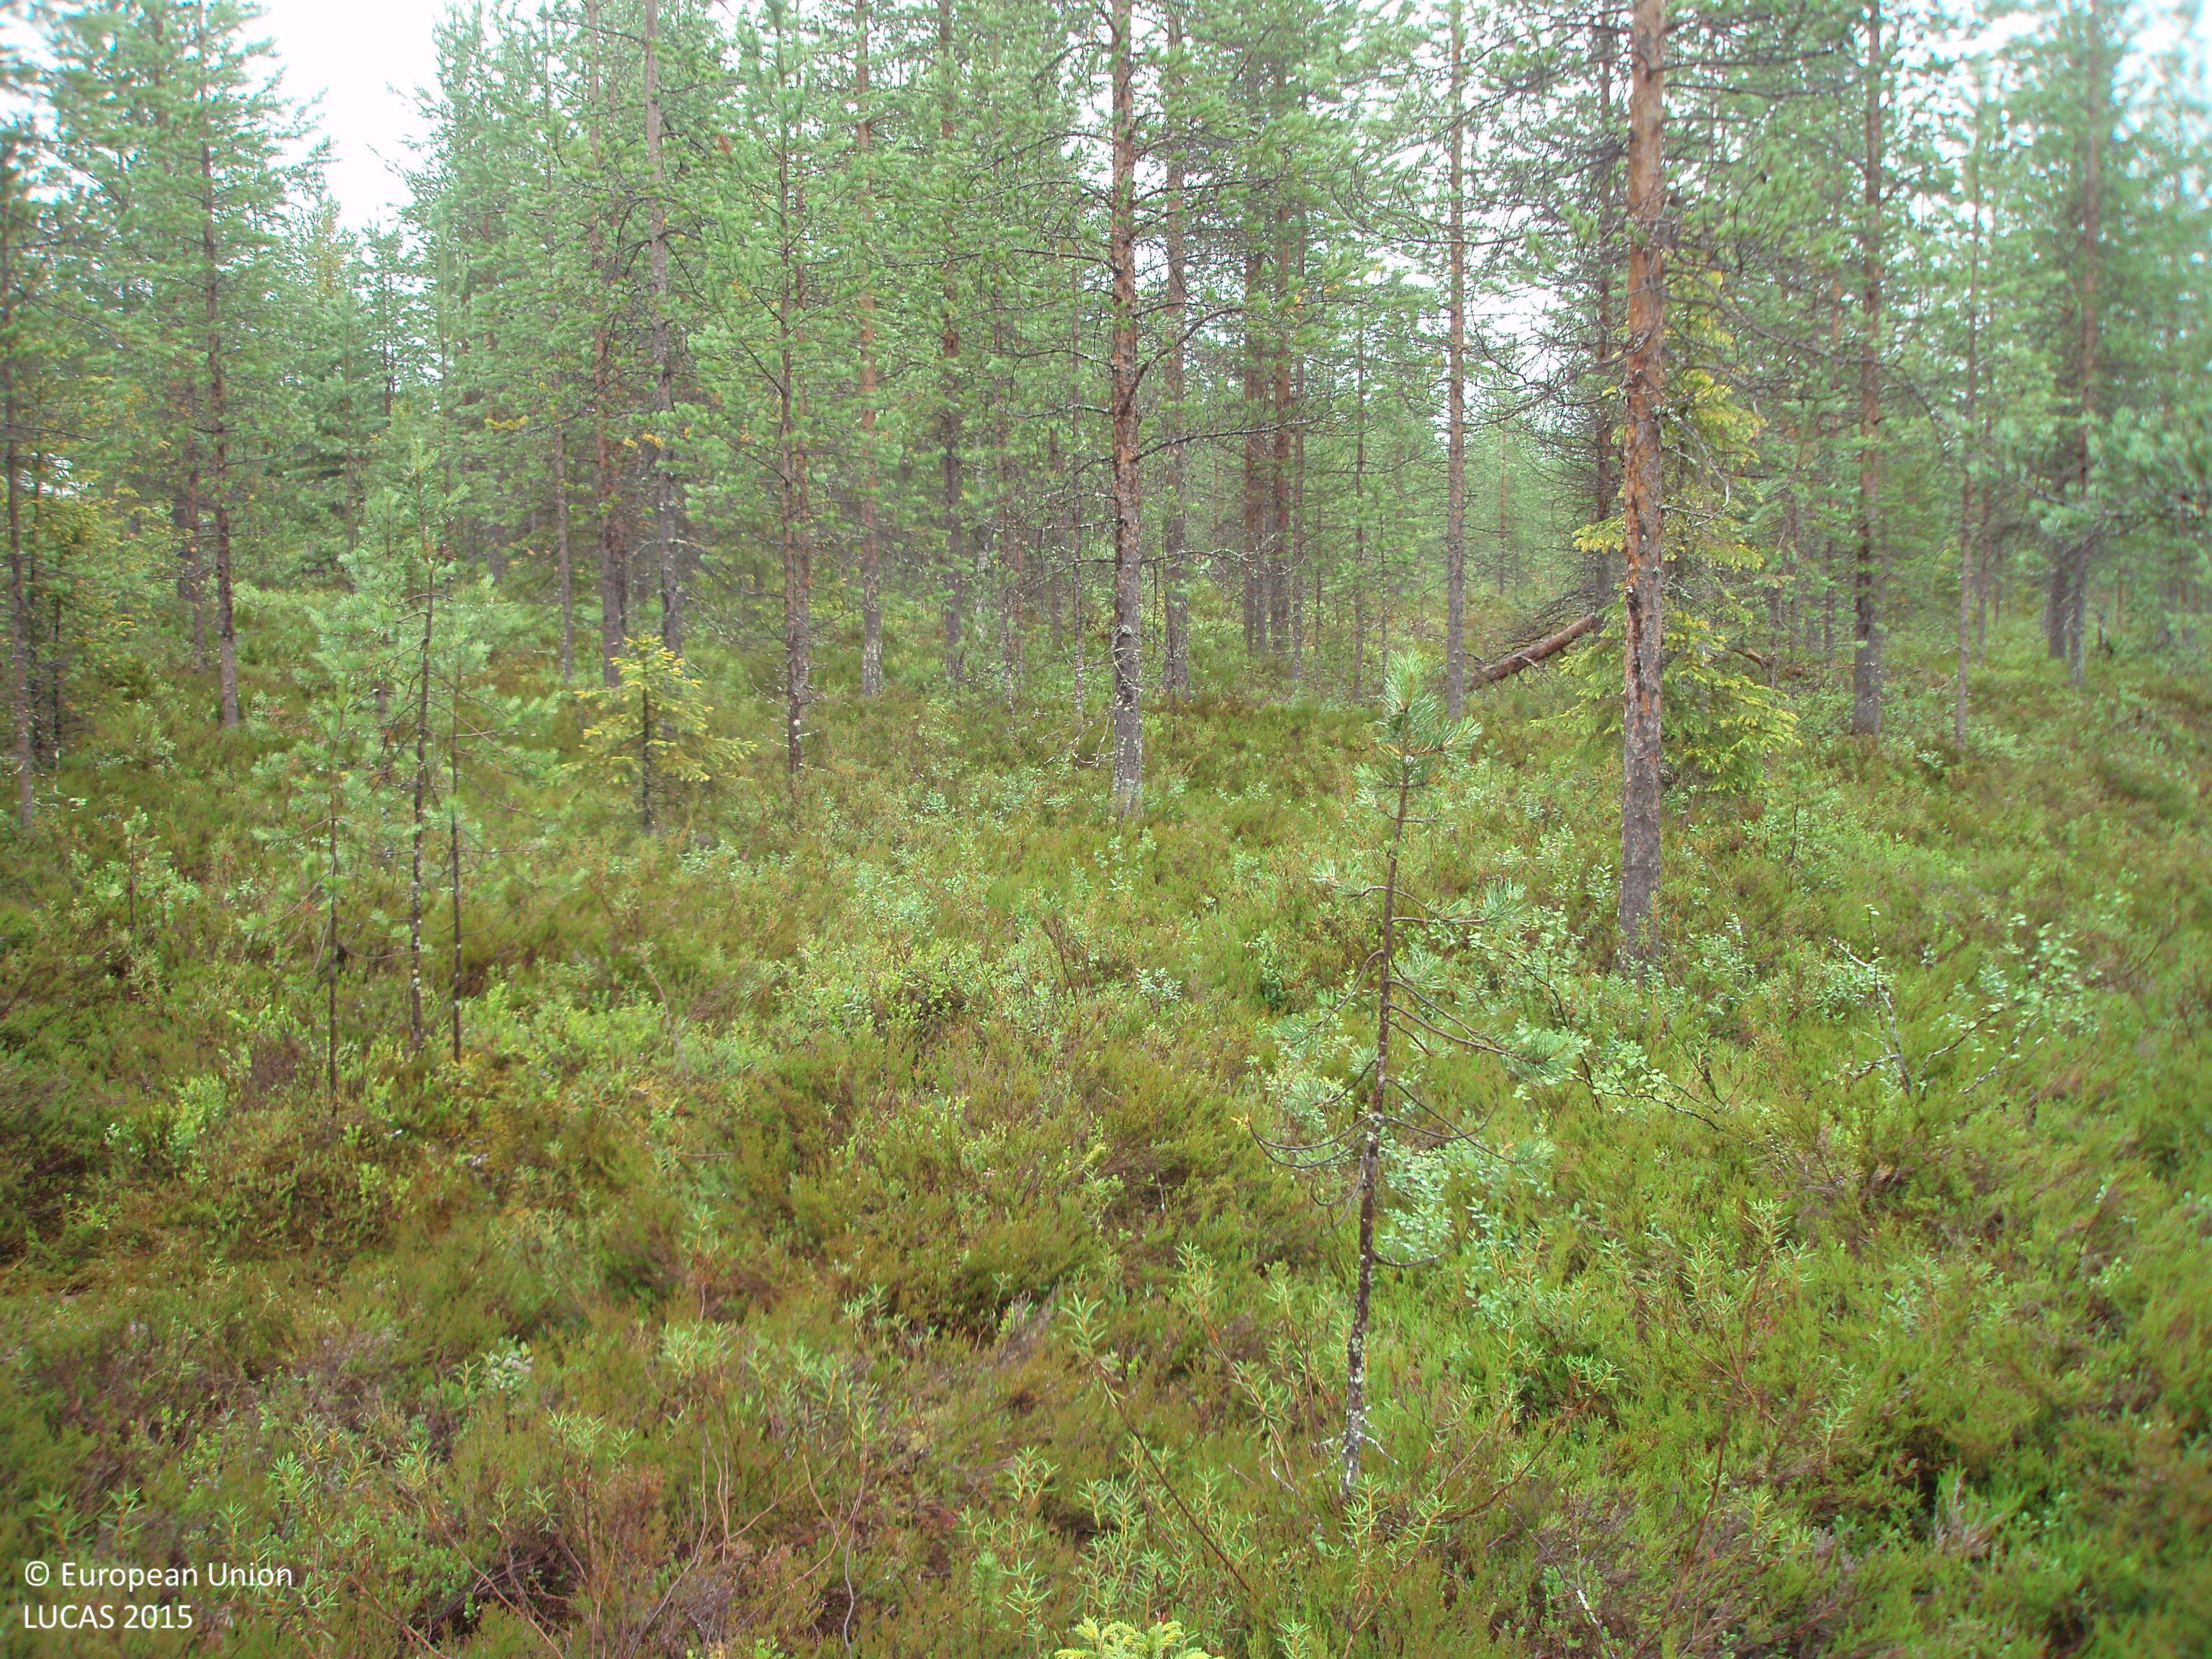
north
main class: Woodland
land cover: Pine dominated coniferous woodland
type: boreal forest
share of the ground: 25 - 50 %
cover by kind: shrubs 60 %, coniferous forest trees 40 %
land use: Forestry
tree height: > 5 m
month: August
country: FI
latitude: 65.5795
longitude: 27.4466
